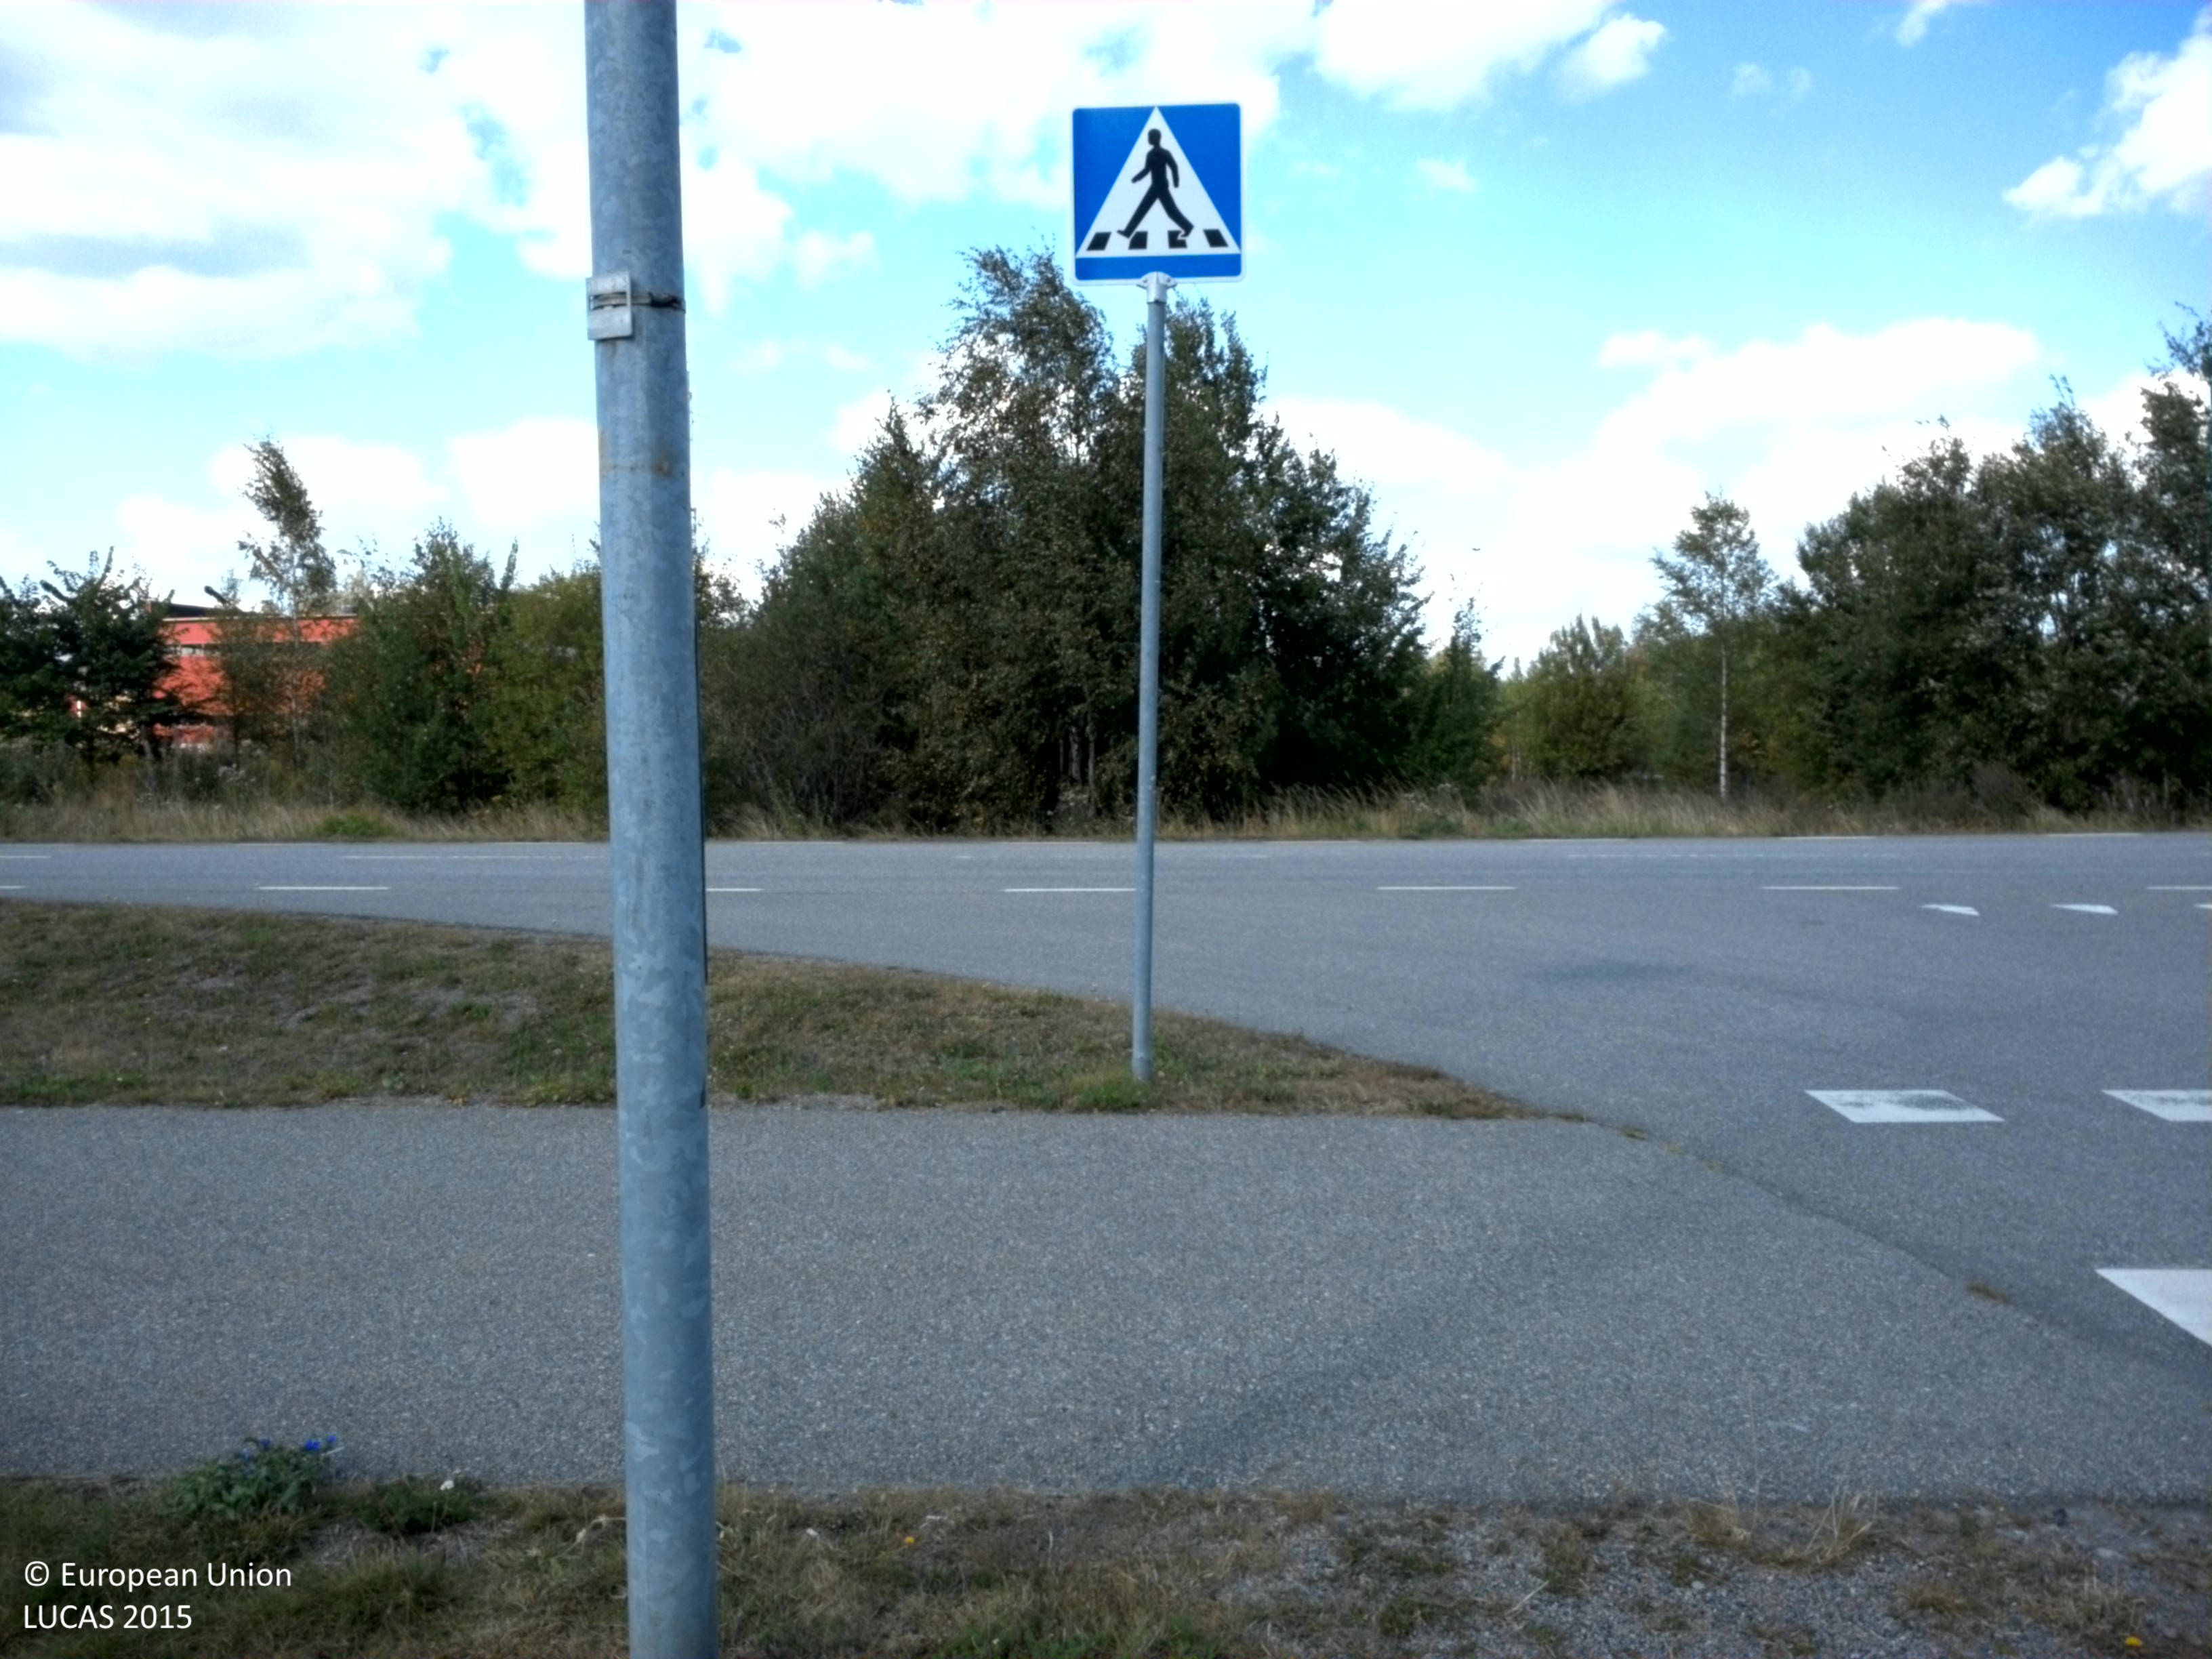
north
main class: Grassland
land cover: Grassland without tree/shrub cover
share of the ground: 50 - 75 %
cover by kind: herbaceous plants 75 %, unconsolidated bare surface 25 %
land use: Road transport
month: August
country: SE
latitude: 60.0766
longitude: 17.7396
